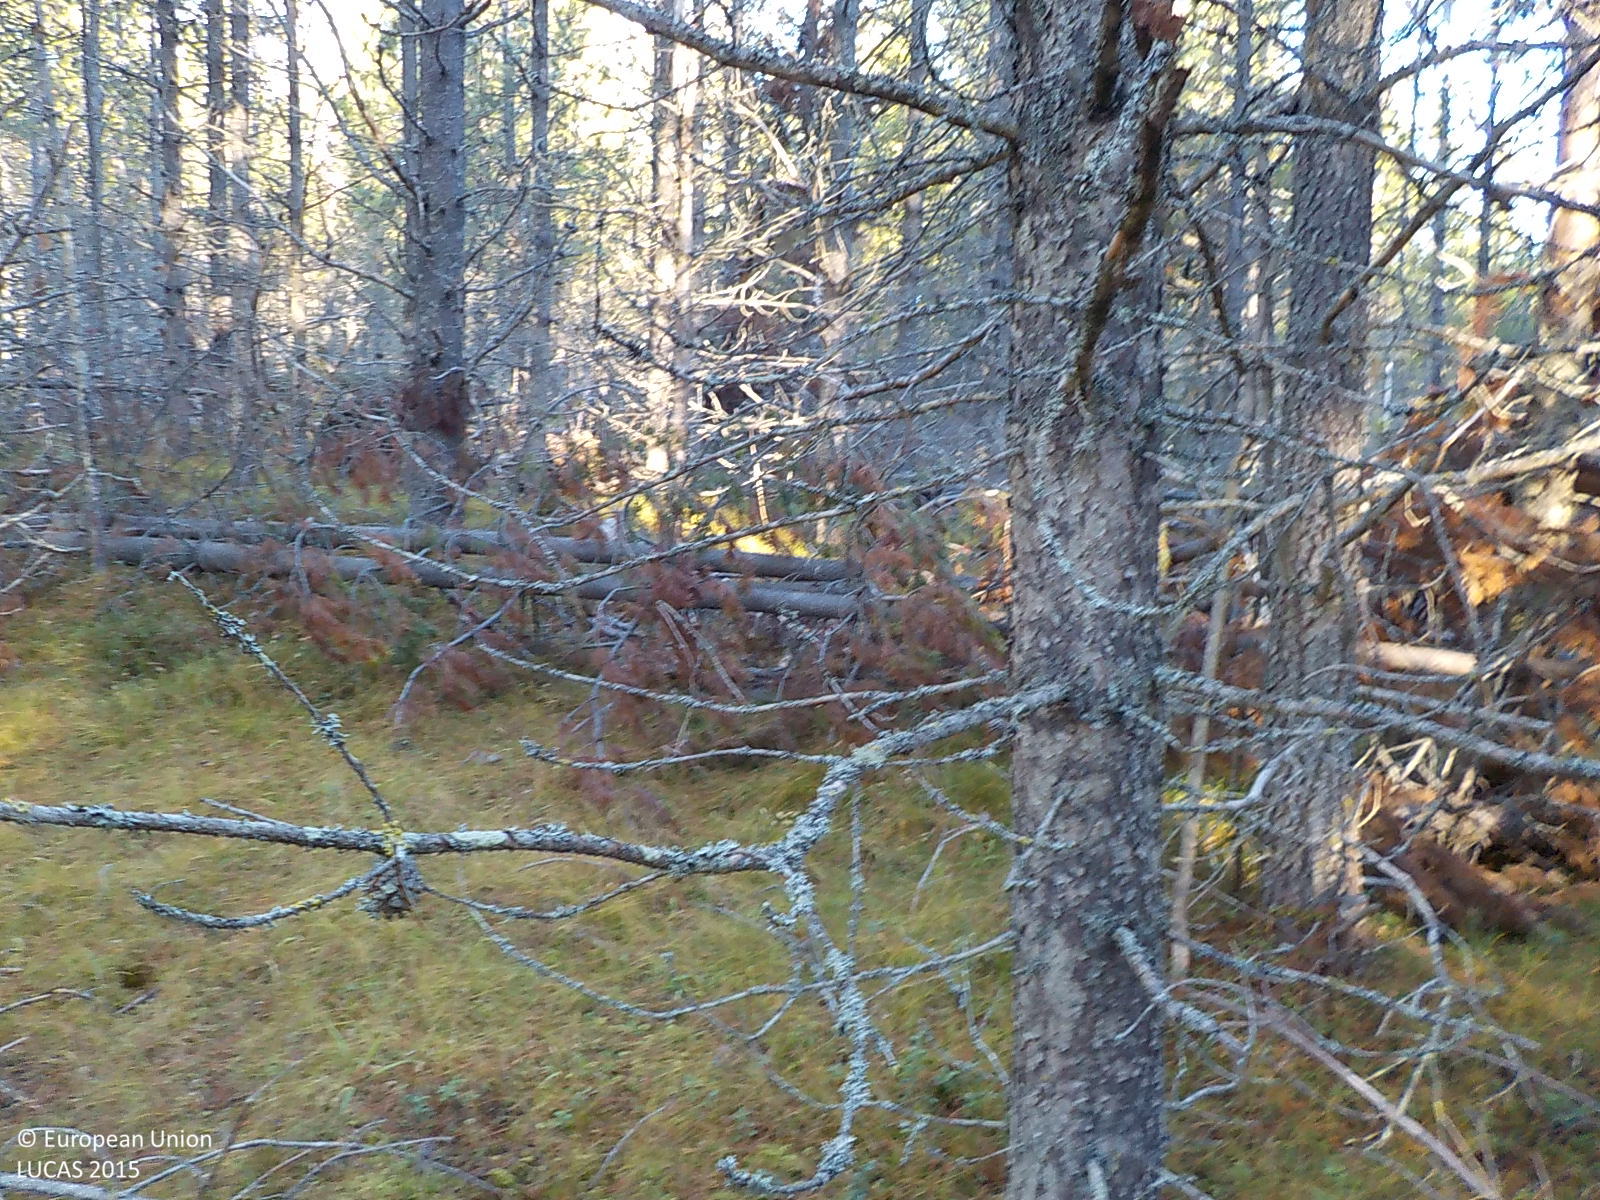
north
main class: Woodland
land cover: Other coniferous woodland
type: boreal forest
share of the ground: > 75 %
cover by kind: coniferous forest trees 75 %, shrubs 25 %
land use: Forestry
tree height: > 5 m
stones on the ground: < 10 %
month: November
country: SE
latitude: 63.2134
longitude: 16.5188
